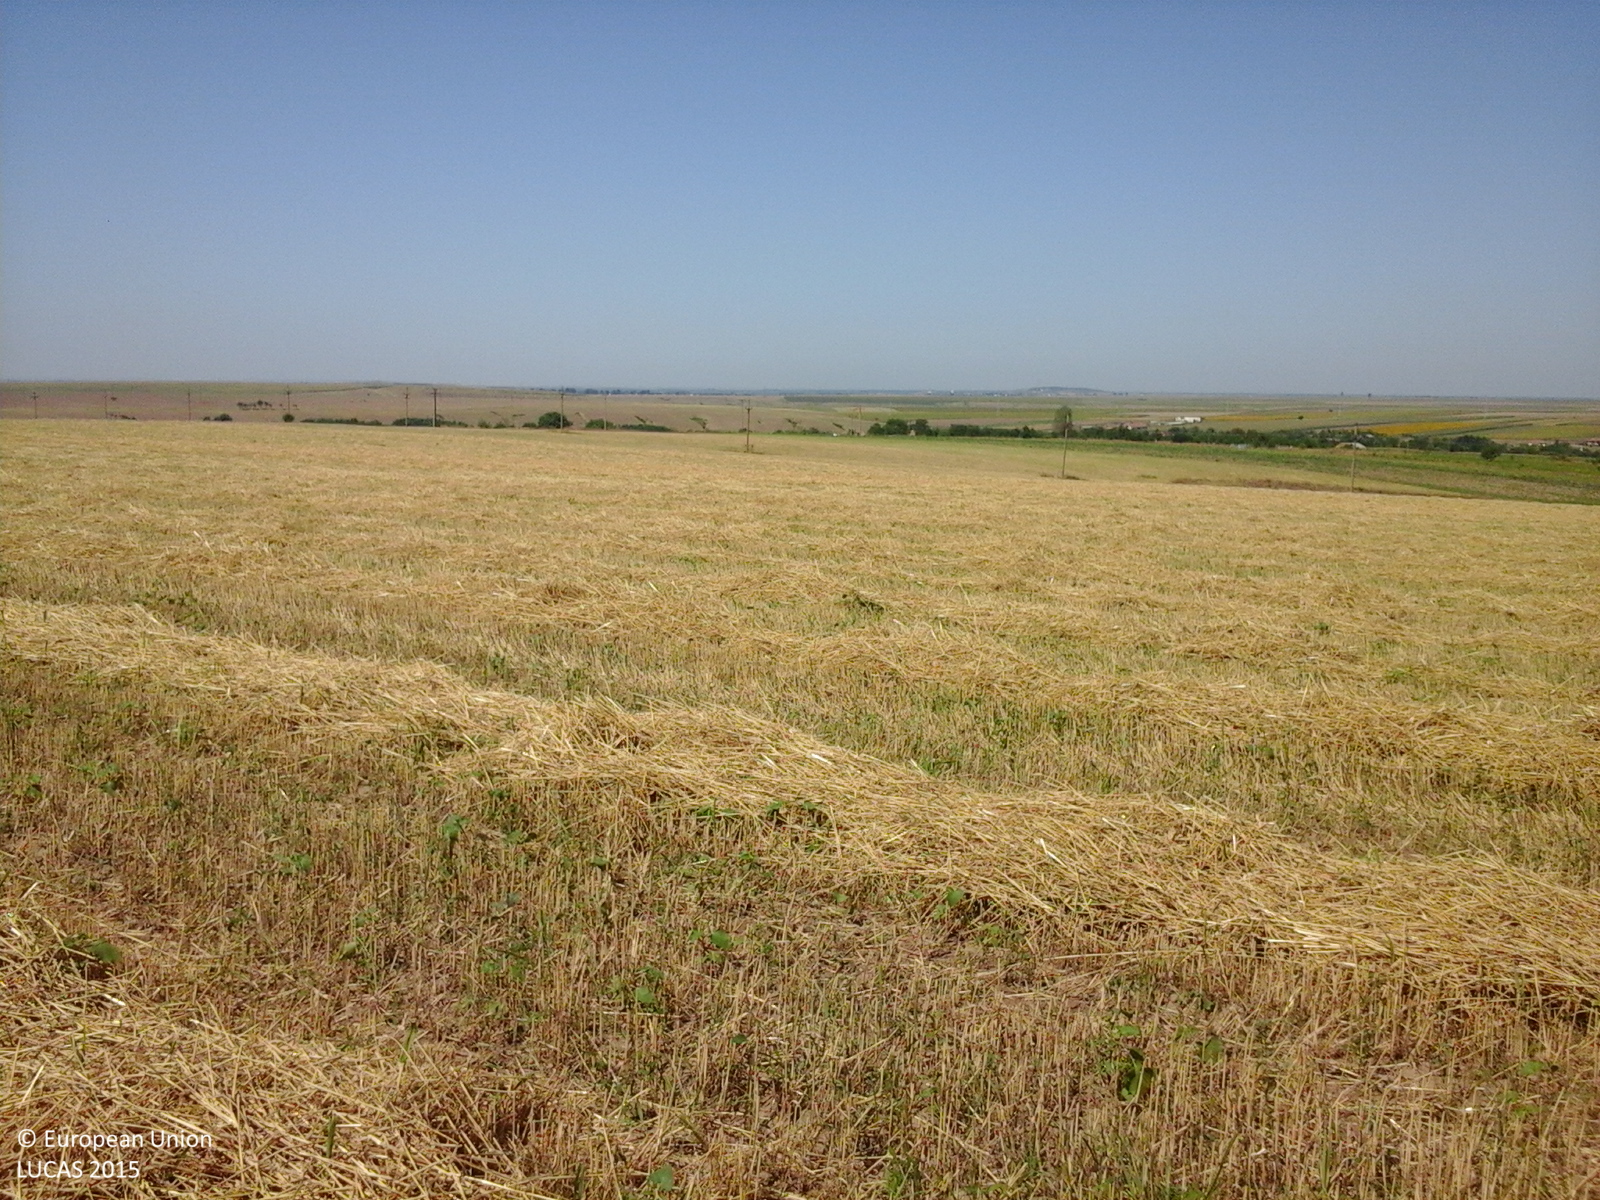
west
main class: Cropland
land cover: Common wheat
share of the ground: 50 - 75 %
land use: Agriculture (excluding fallow land and kitchen gardens)
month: August
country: RO
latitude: 44.6812
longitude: 28.0903
